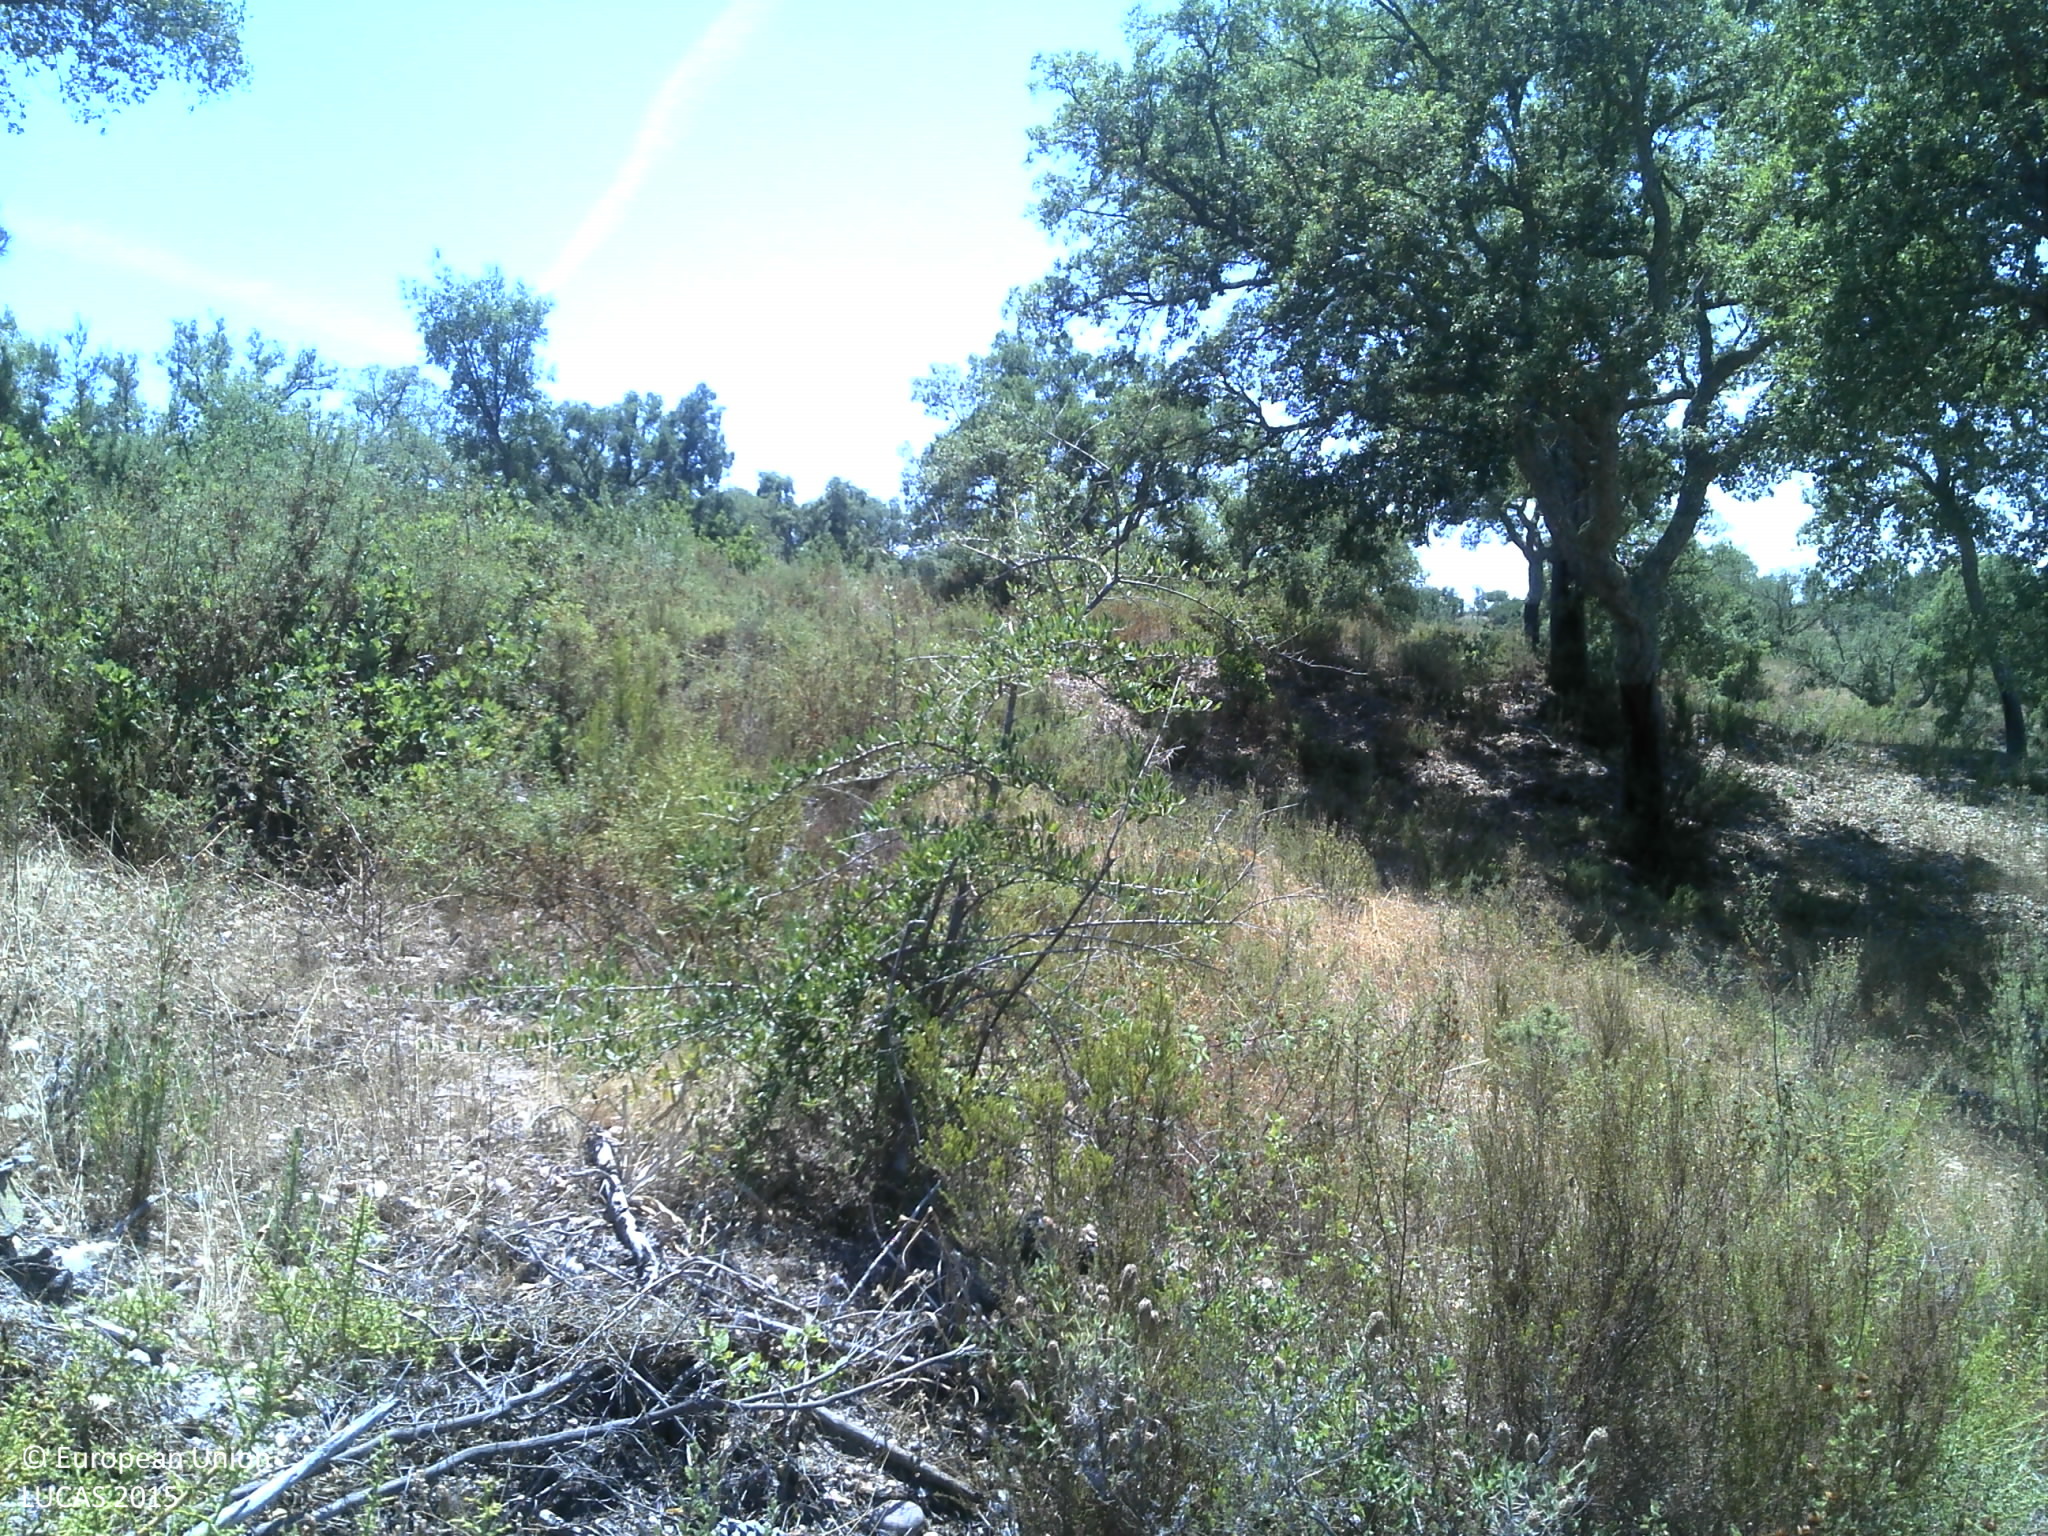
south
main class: Grassland
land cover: Grassland with sparse tree/shrub cover
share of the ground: 25 - 50 %
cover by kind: herbaceous plants 45 %, unconsolidated bare surface 40 %, shrubs 10 %, broadleaved forest trees 5 %
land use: Forestry
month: July
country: PT
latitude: 39.2176
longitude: -8.2801
